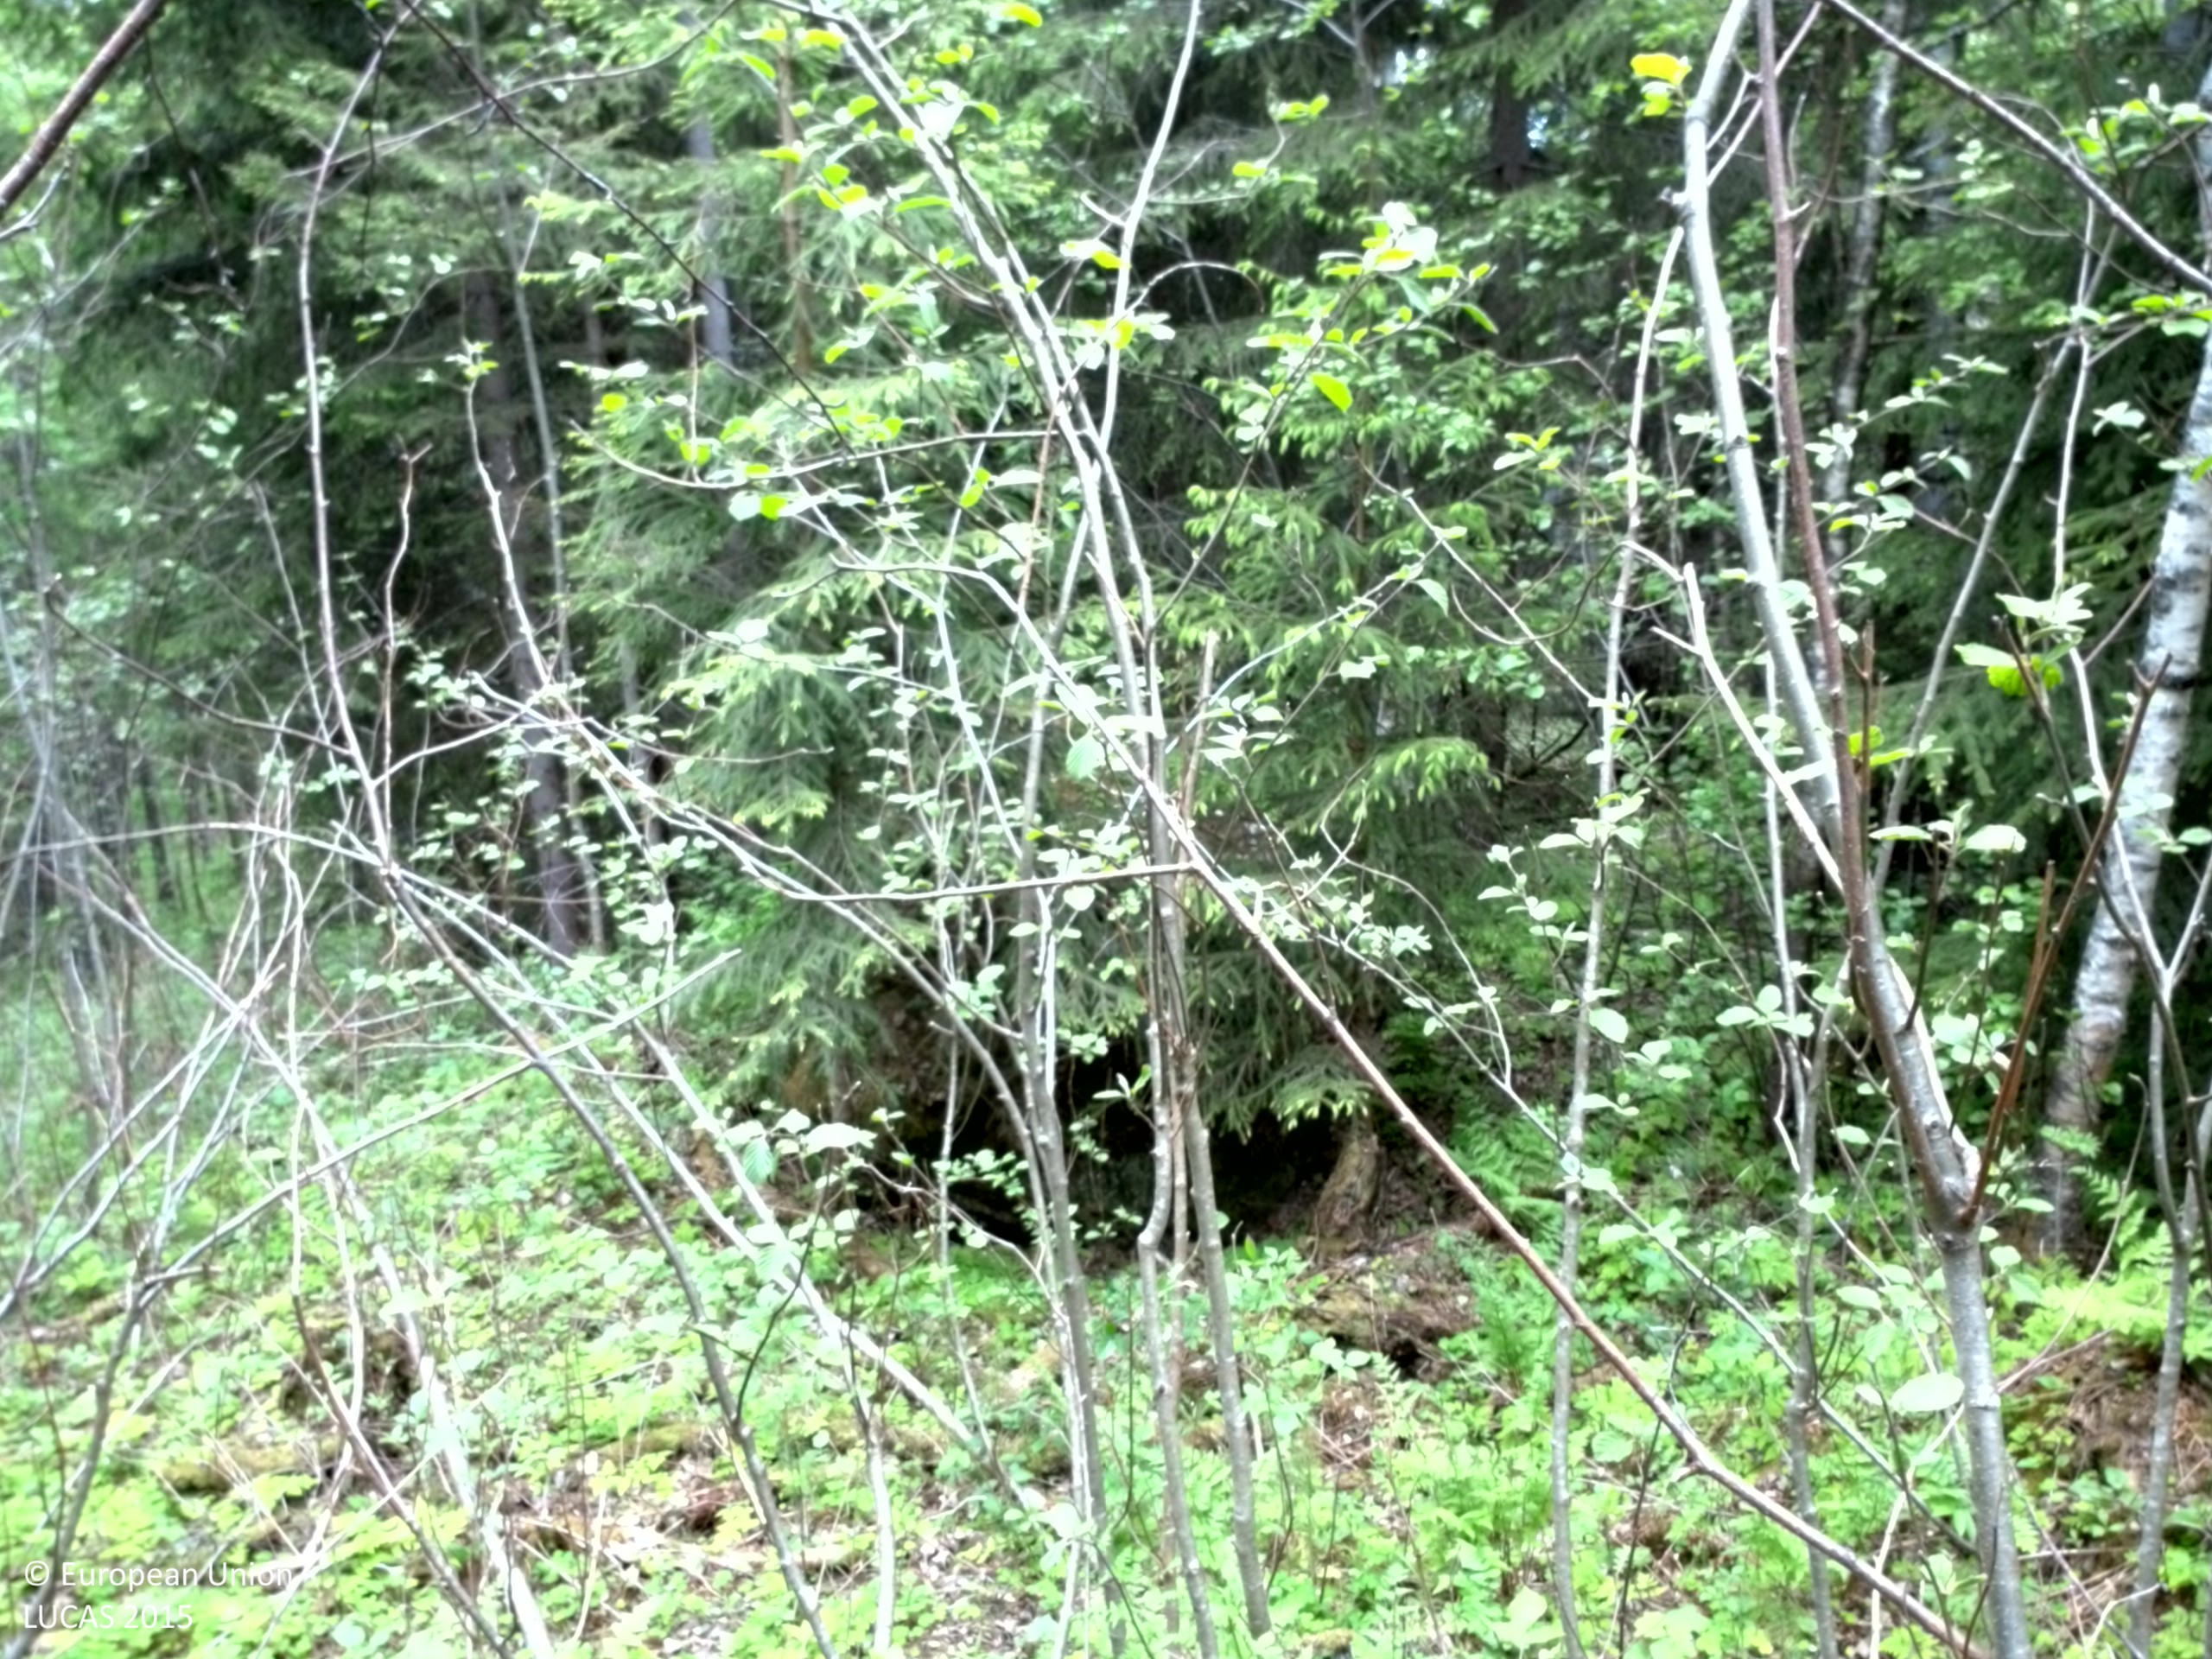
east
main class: Woodland
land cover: Other mixed woodland
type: boreal forest
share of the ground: > 75 %
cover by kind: broadleaved forest trees 60 %, coniferous forest trees 30 %, herbaceous plants 10 %
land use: Forestry
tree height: > 5 m
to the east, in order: Other mixed woodland; Pine dominated mixed woodland; Other mixed woodland
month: June
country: SE
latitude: 63.1030
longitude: 17.7239
